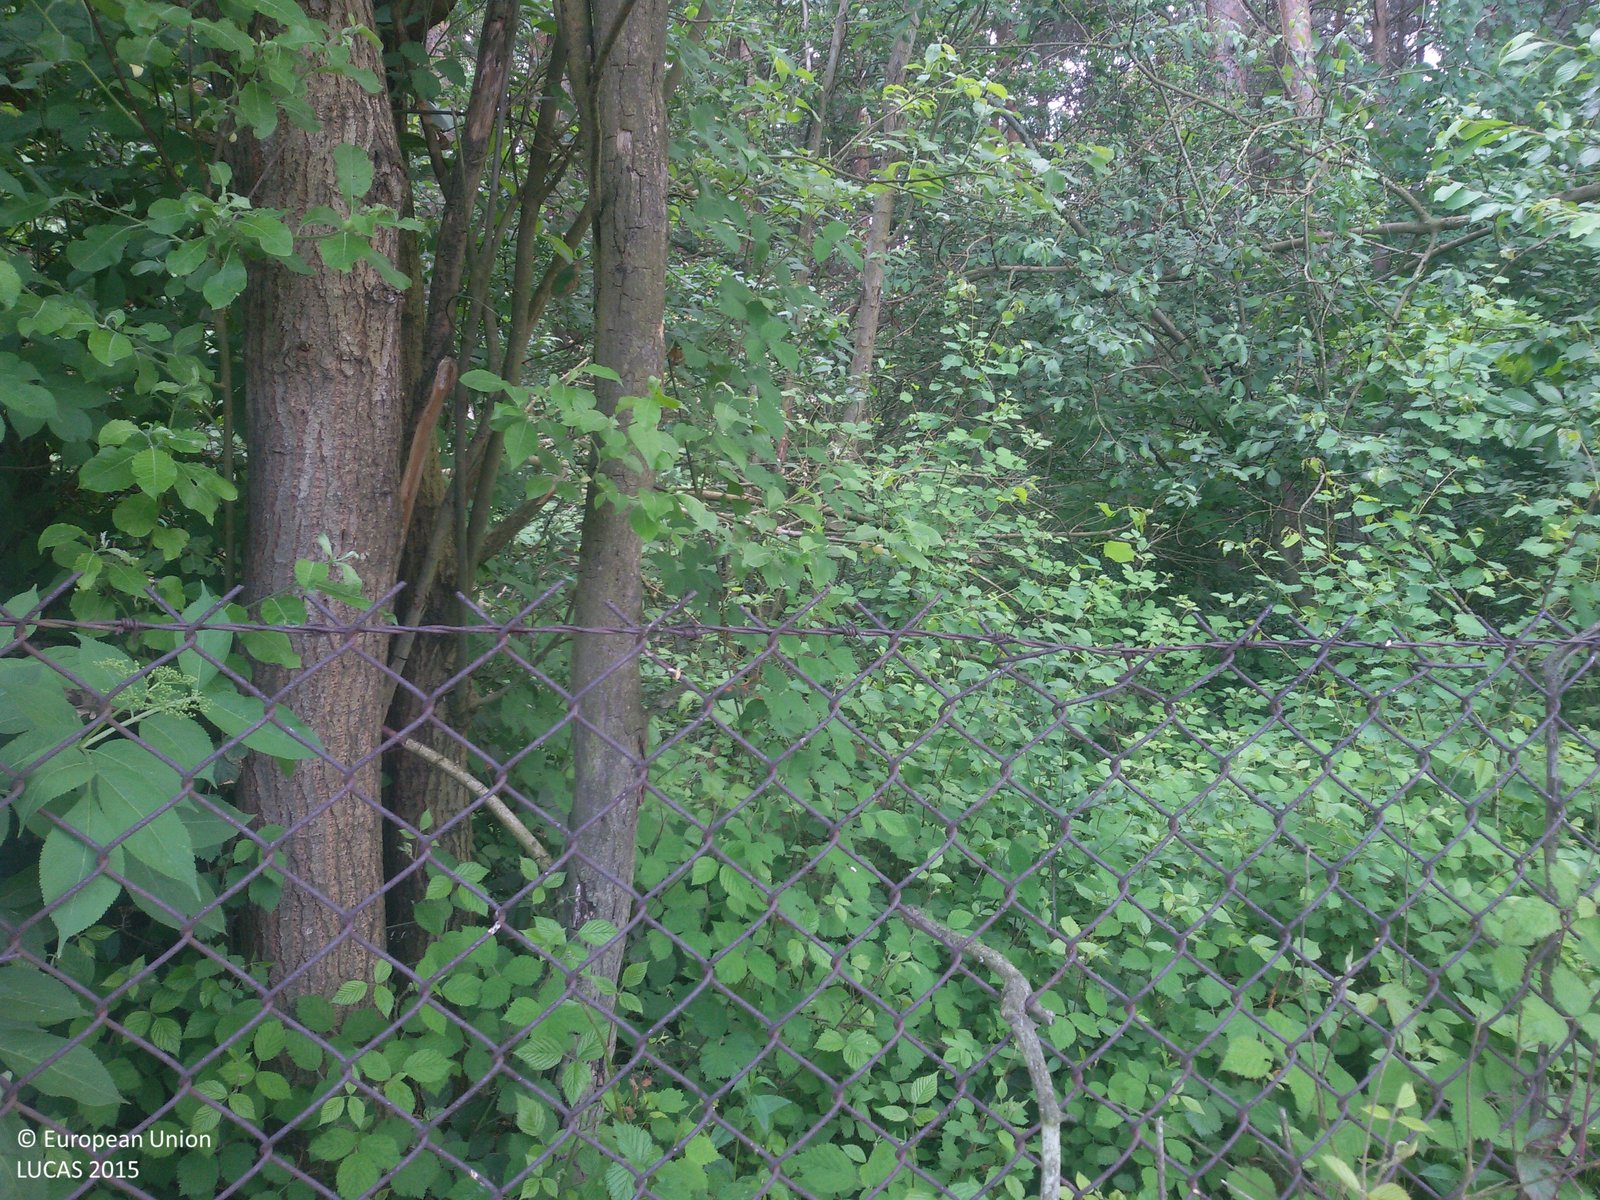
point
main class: Woodland
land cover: Pine dominated mixed woodland
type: hemiboreal forest and nemoral coniferous forest and mixed broadleaved-coniferous forest
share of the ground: > 75 %
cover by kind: coniferous forest trees 60 %, broadleaved forest trees 40 %
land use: Semi-natural and natural areas not in use
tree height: > 5 m
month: June
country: PL
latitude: 51.6952
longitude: 20.6741
